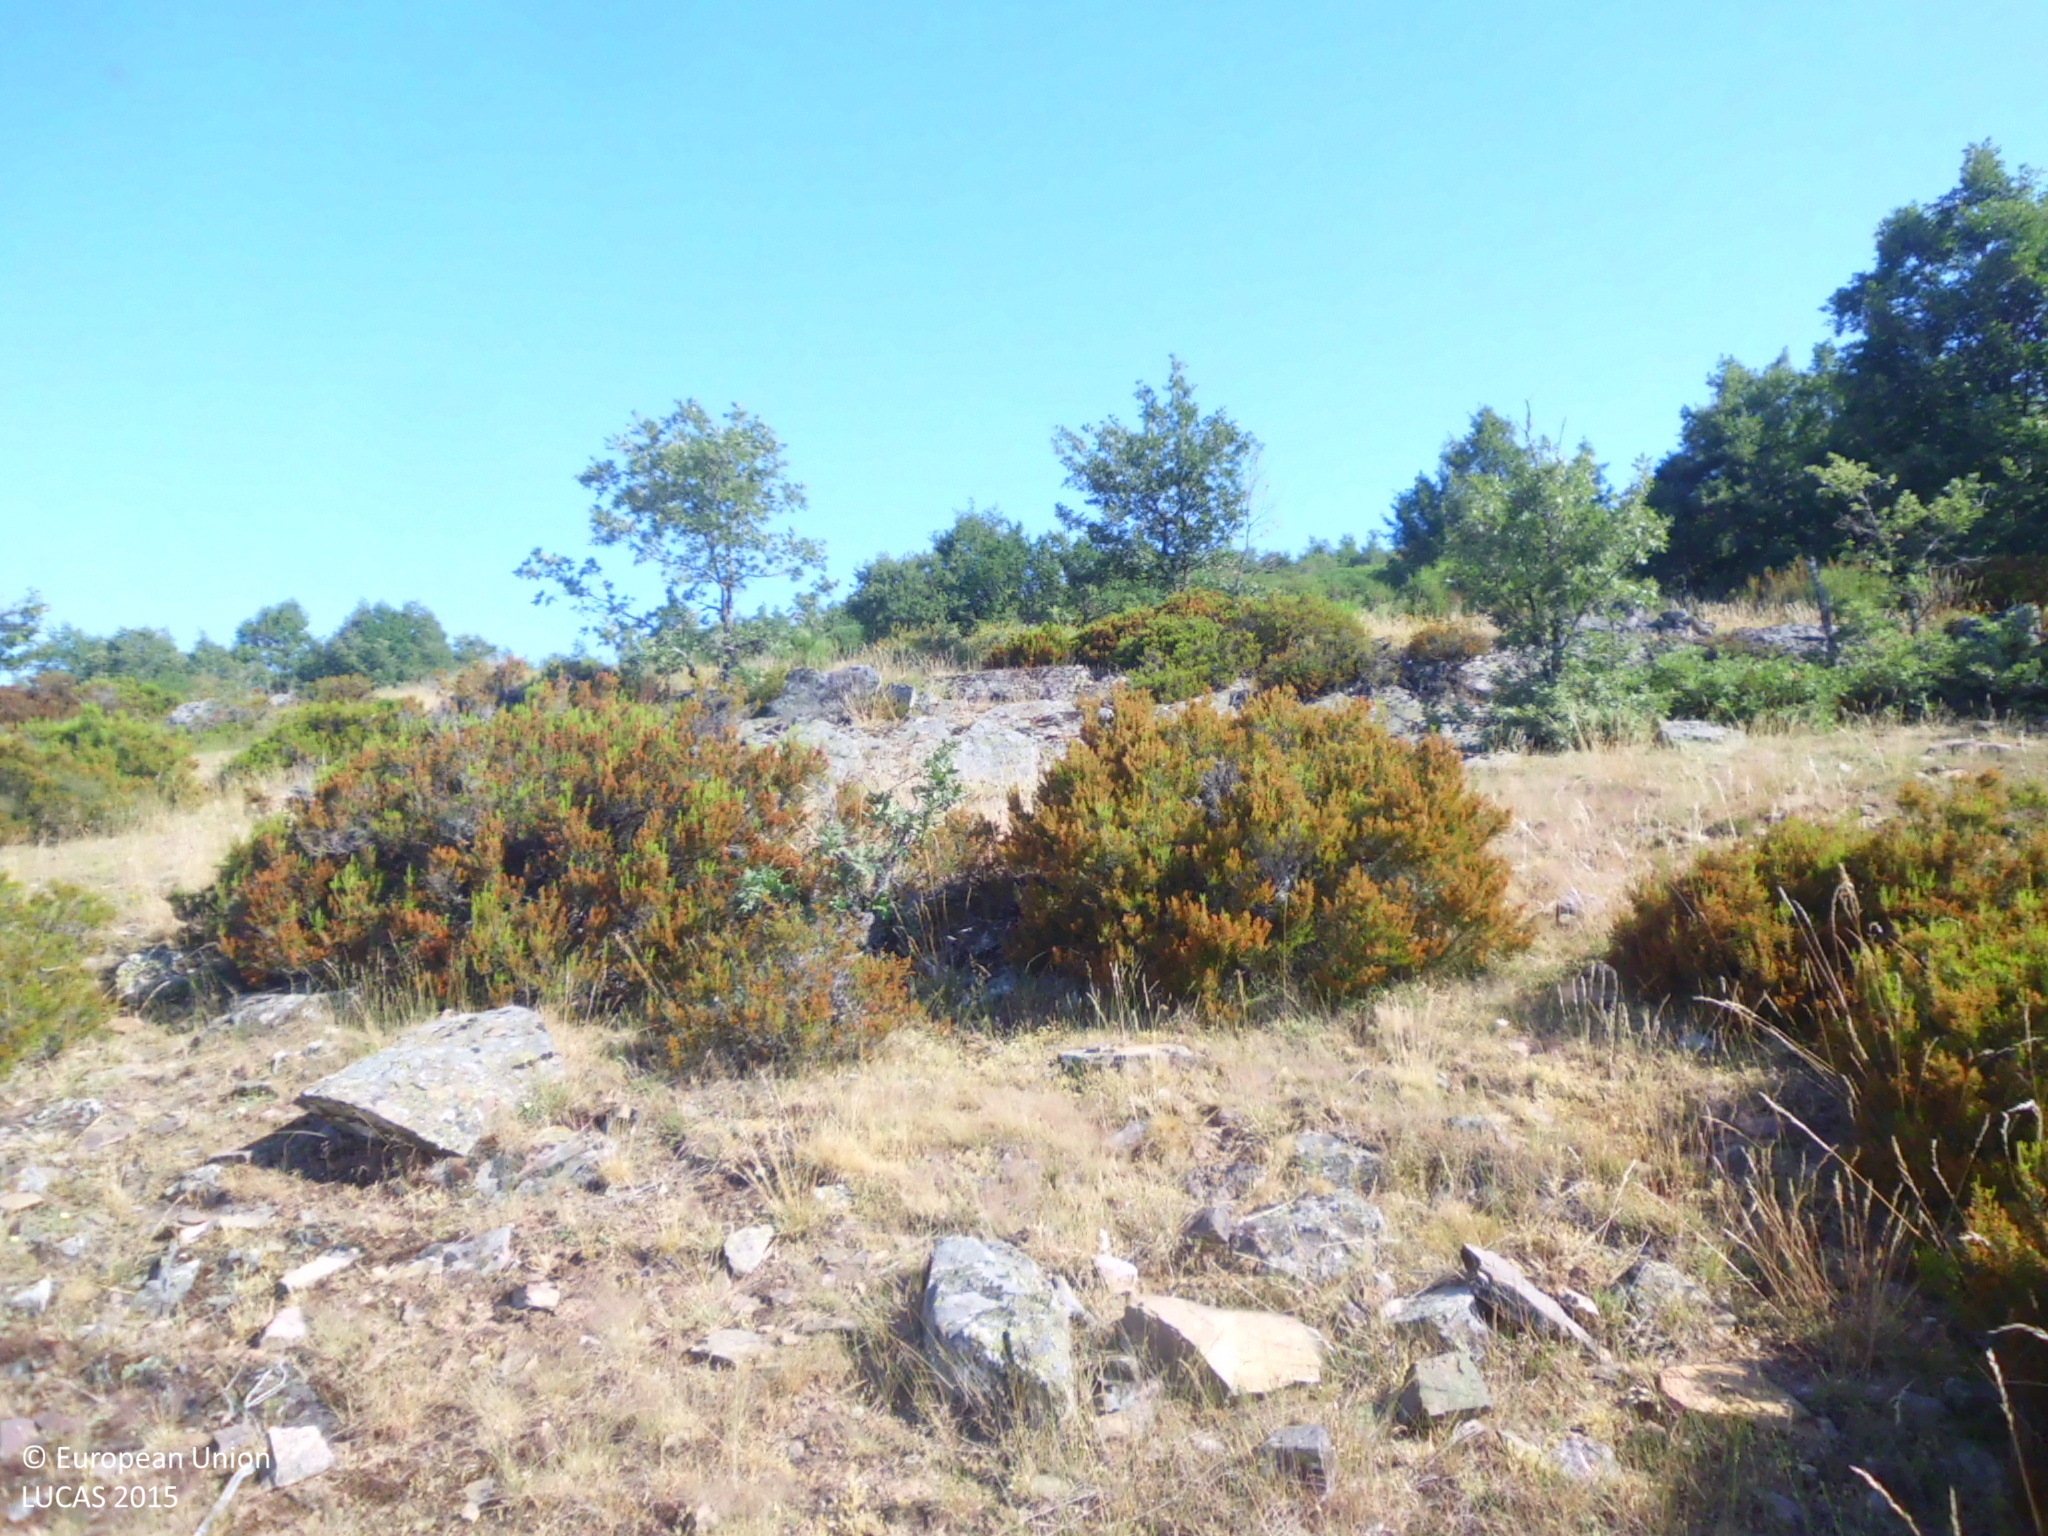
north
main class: Woodland
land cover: Broadleaved woodland
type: broadleaved evergreen forest
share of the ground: > 75 %
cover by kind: broadleaved forest trees 80 %, shrubs 20 %
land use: Forestry
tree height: > 5 m
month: July
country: ES
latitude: 42.1881
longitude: -3.3366
